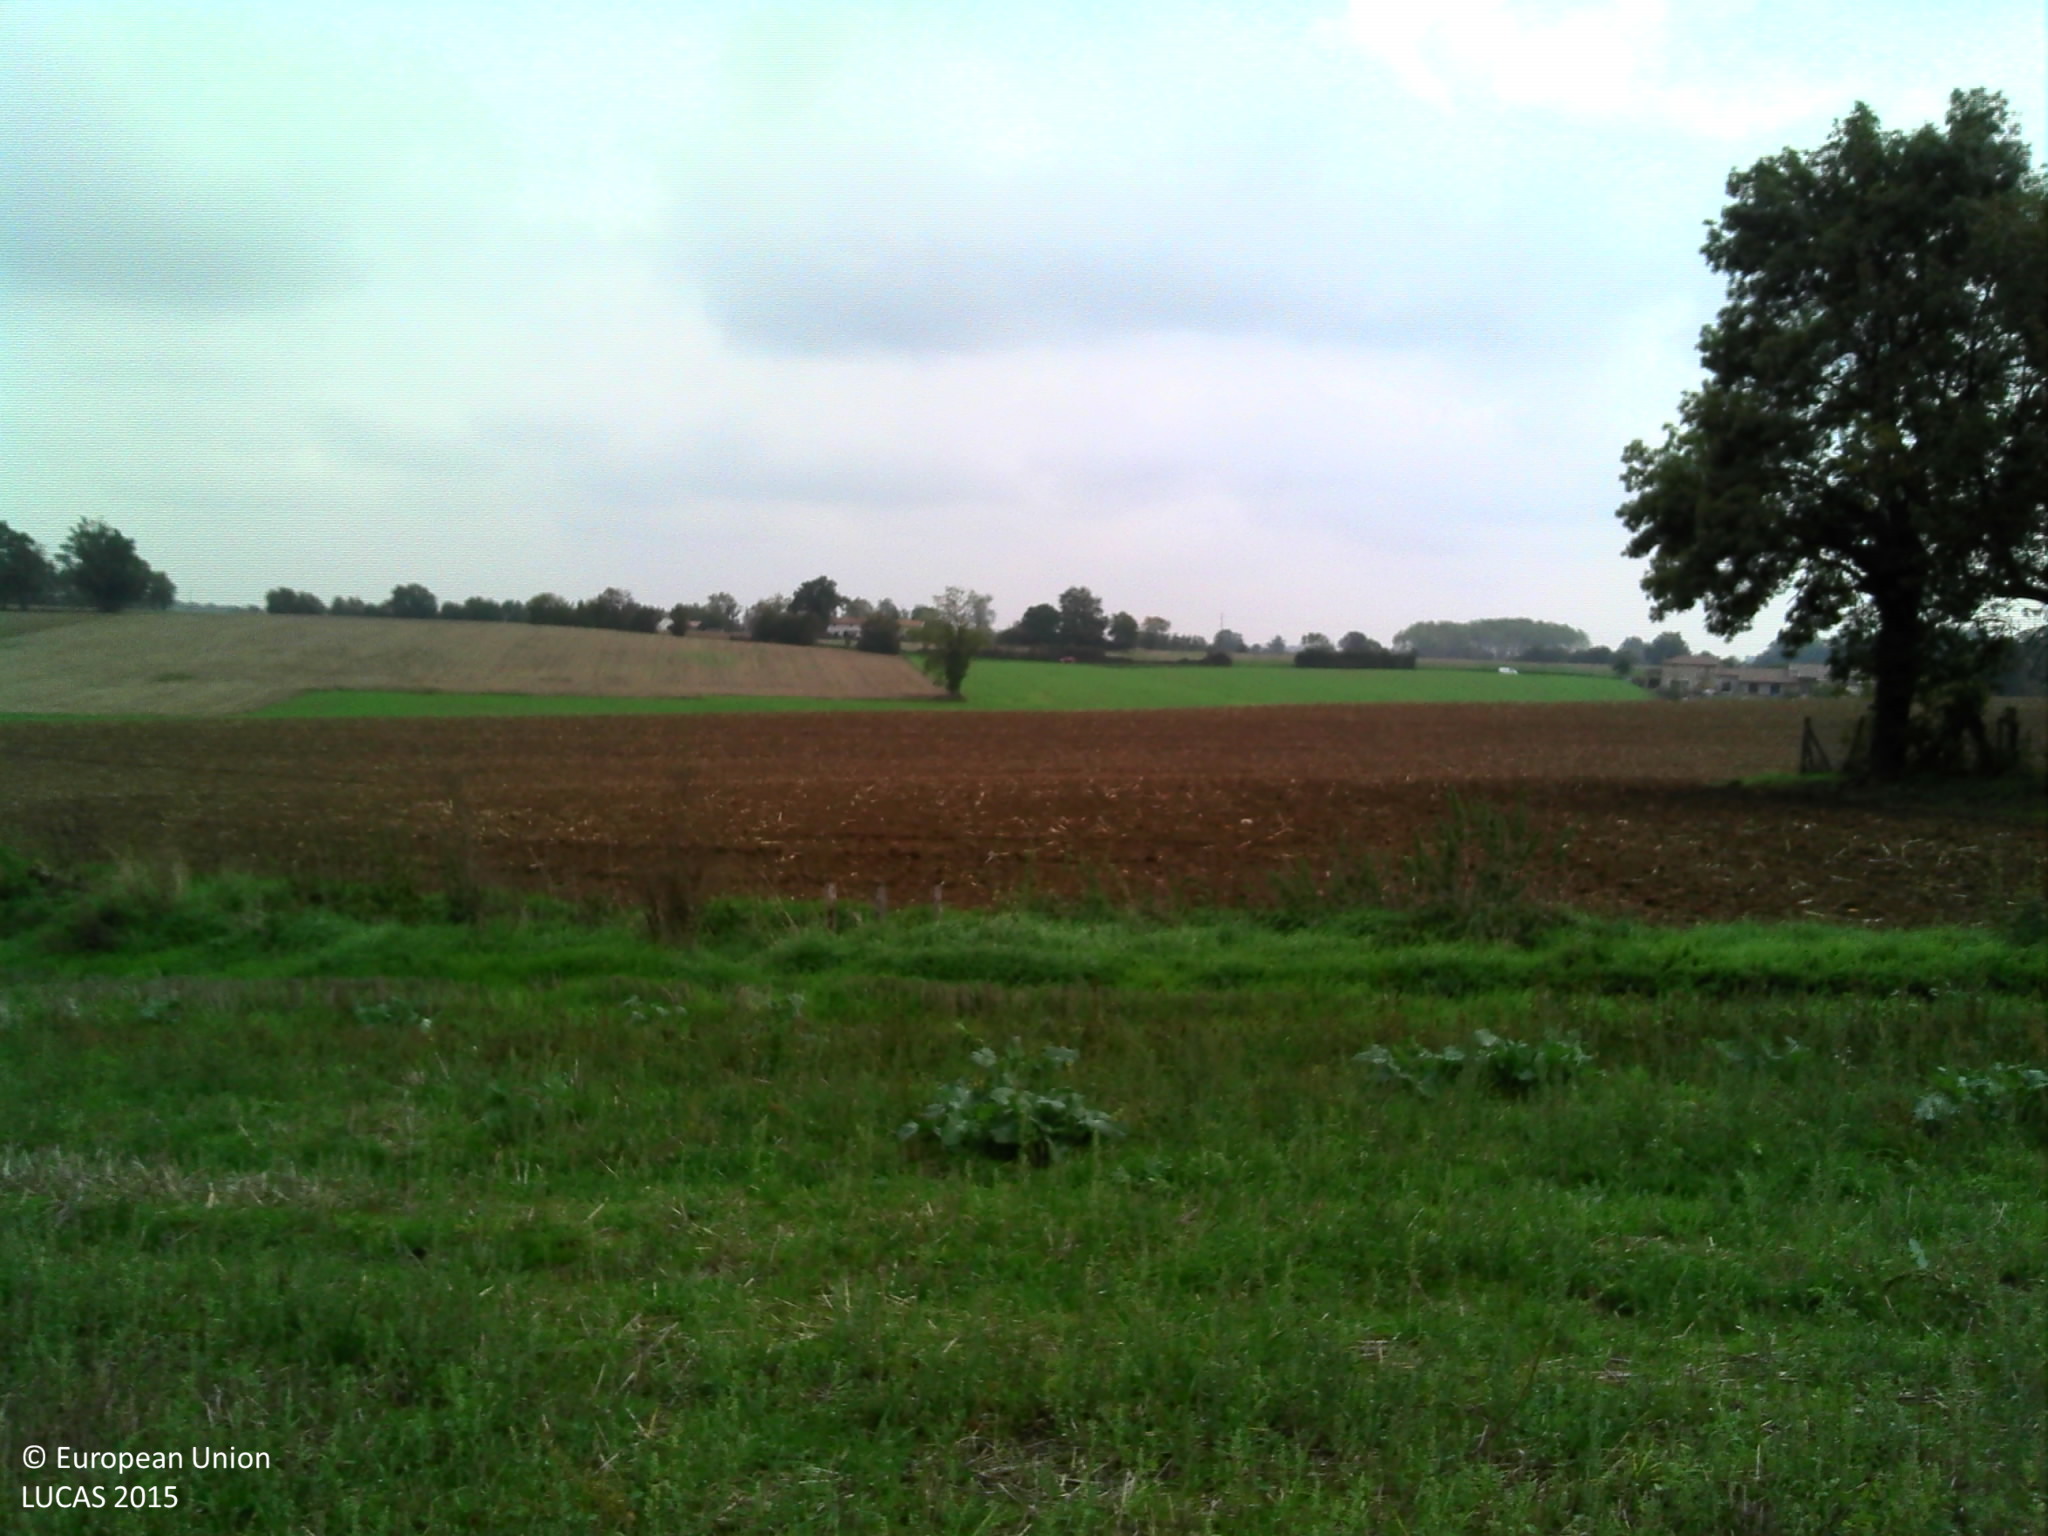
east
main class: Cropland
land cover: Common wheat
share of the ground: < 10 %
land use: Agriculture (excluding fallow land and kitchen gardens)
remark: Harvested field
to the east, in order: Common wheat; Grass margins; Ditches and canals; Grass margins; Other bare soil; Tracks; Fences; Lines of trees; Grassland with sparse tree/shrub cover; Fences; Grass margins; Other bare soil
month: October
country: FR
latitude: 46.1915
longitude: 4.8586
